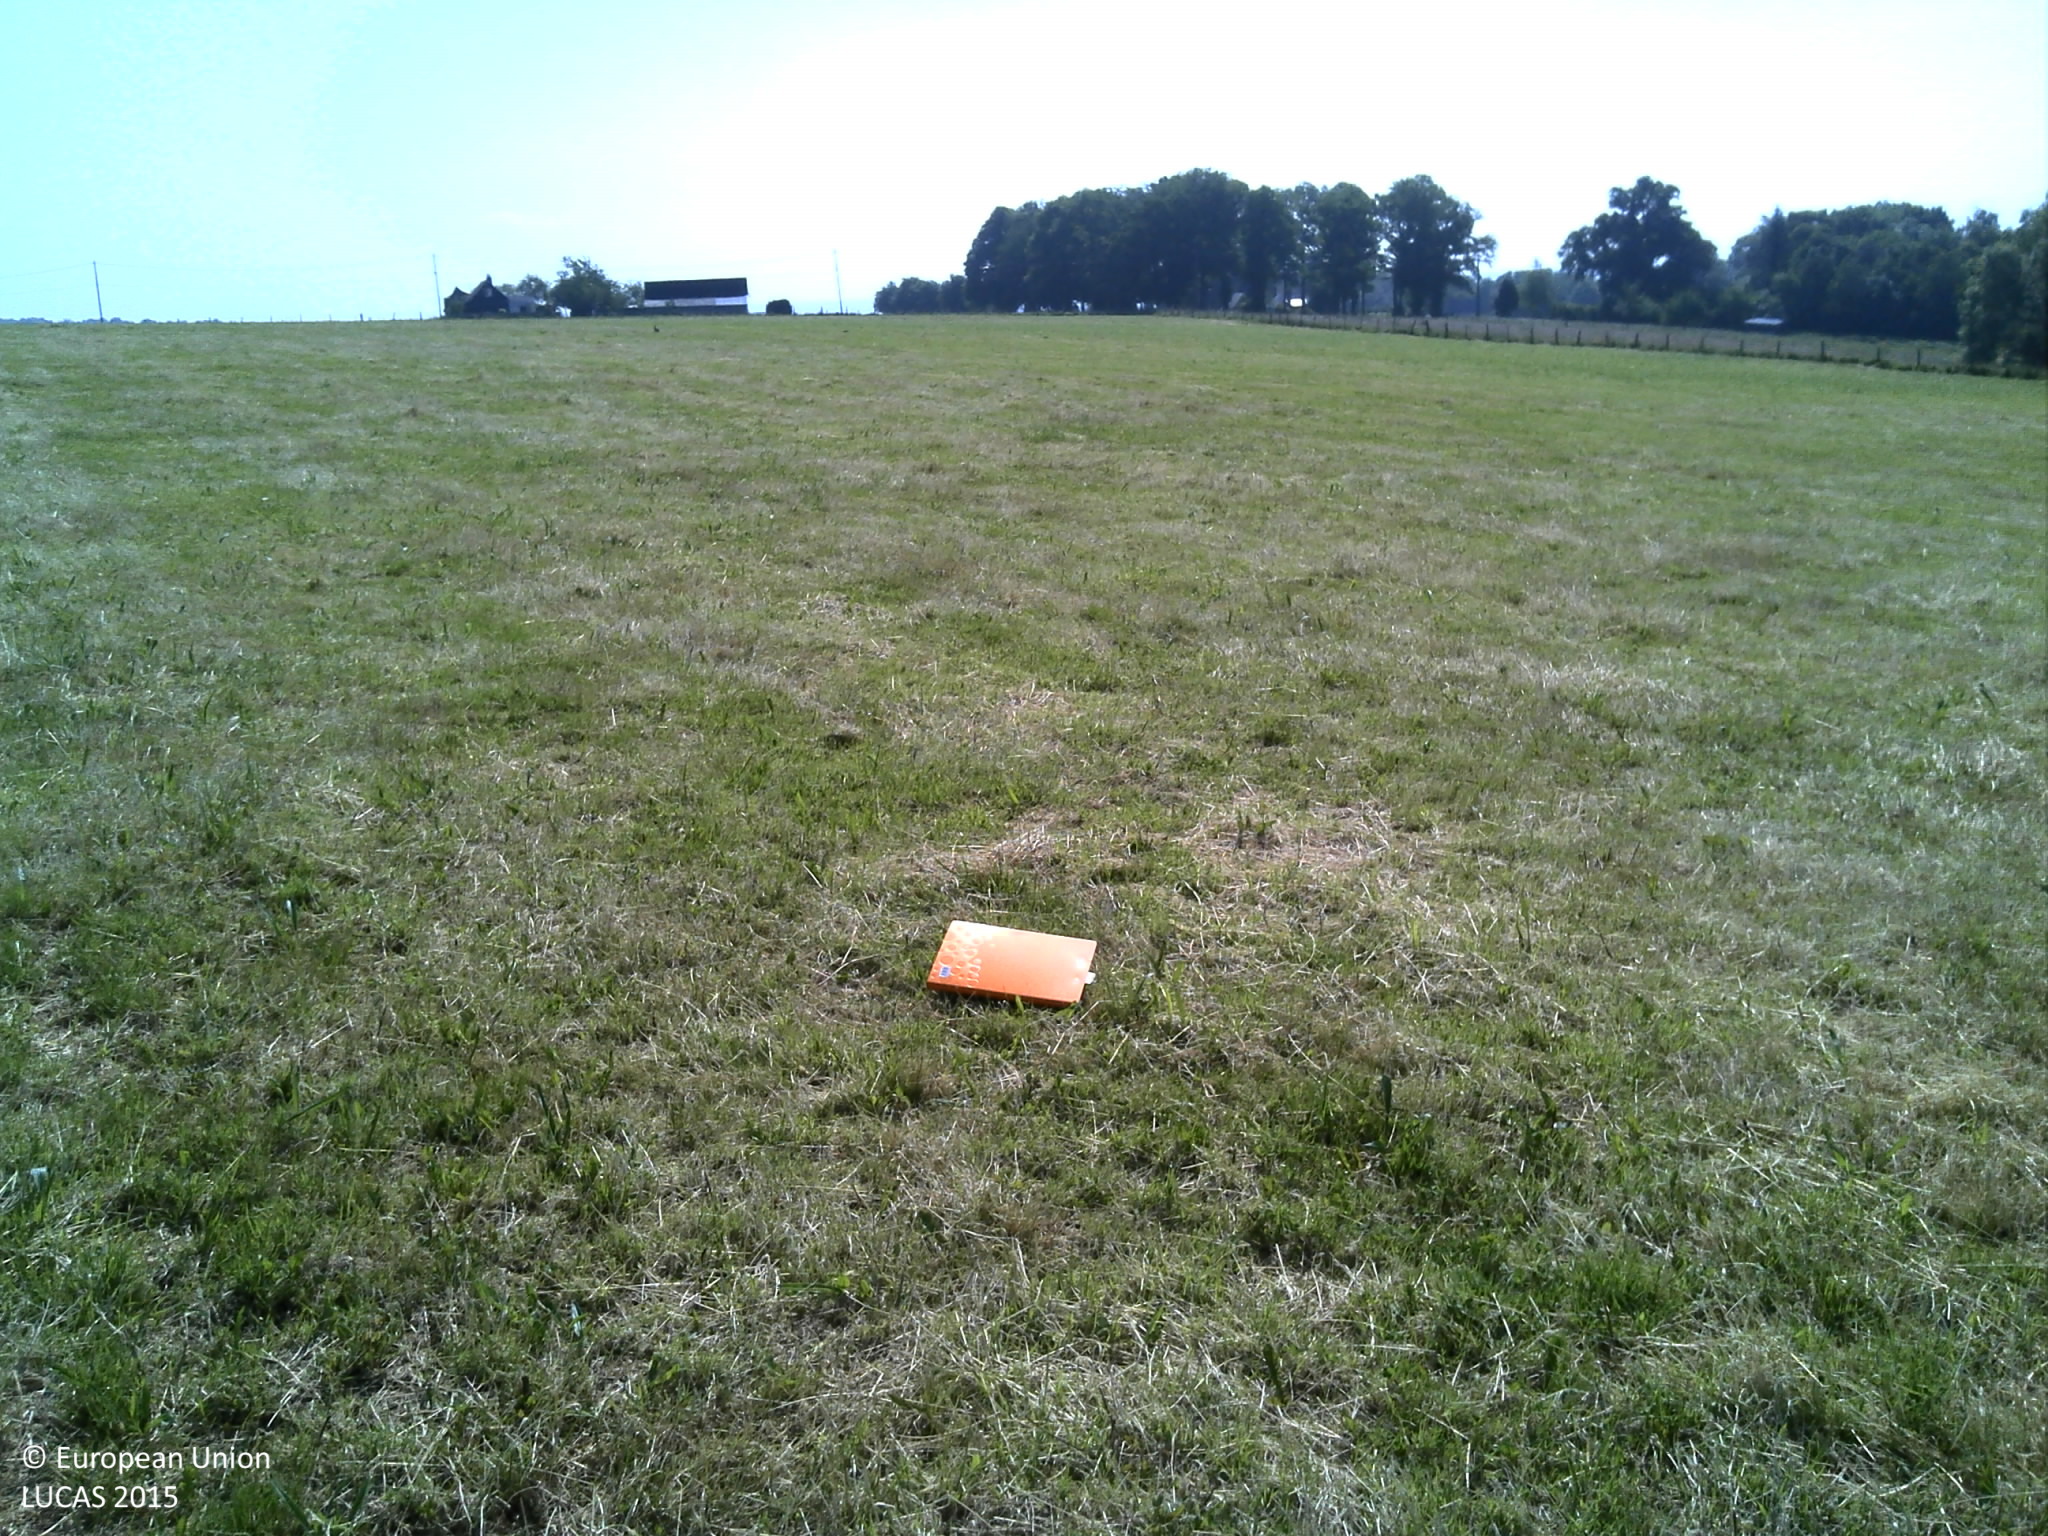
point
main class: Grassland
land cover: Grassland without tree/shrub cover
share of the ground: > 75 %
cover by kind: herbaceous plants 100 %
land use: Agriculture (excluding fallow land and kitchen gardens)
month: June
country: FR
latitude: 49.4897
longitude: 0.6285
